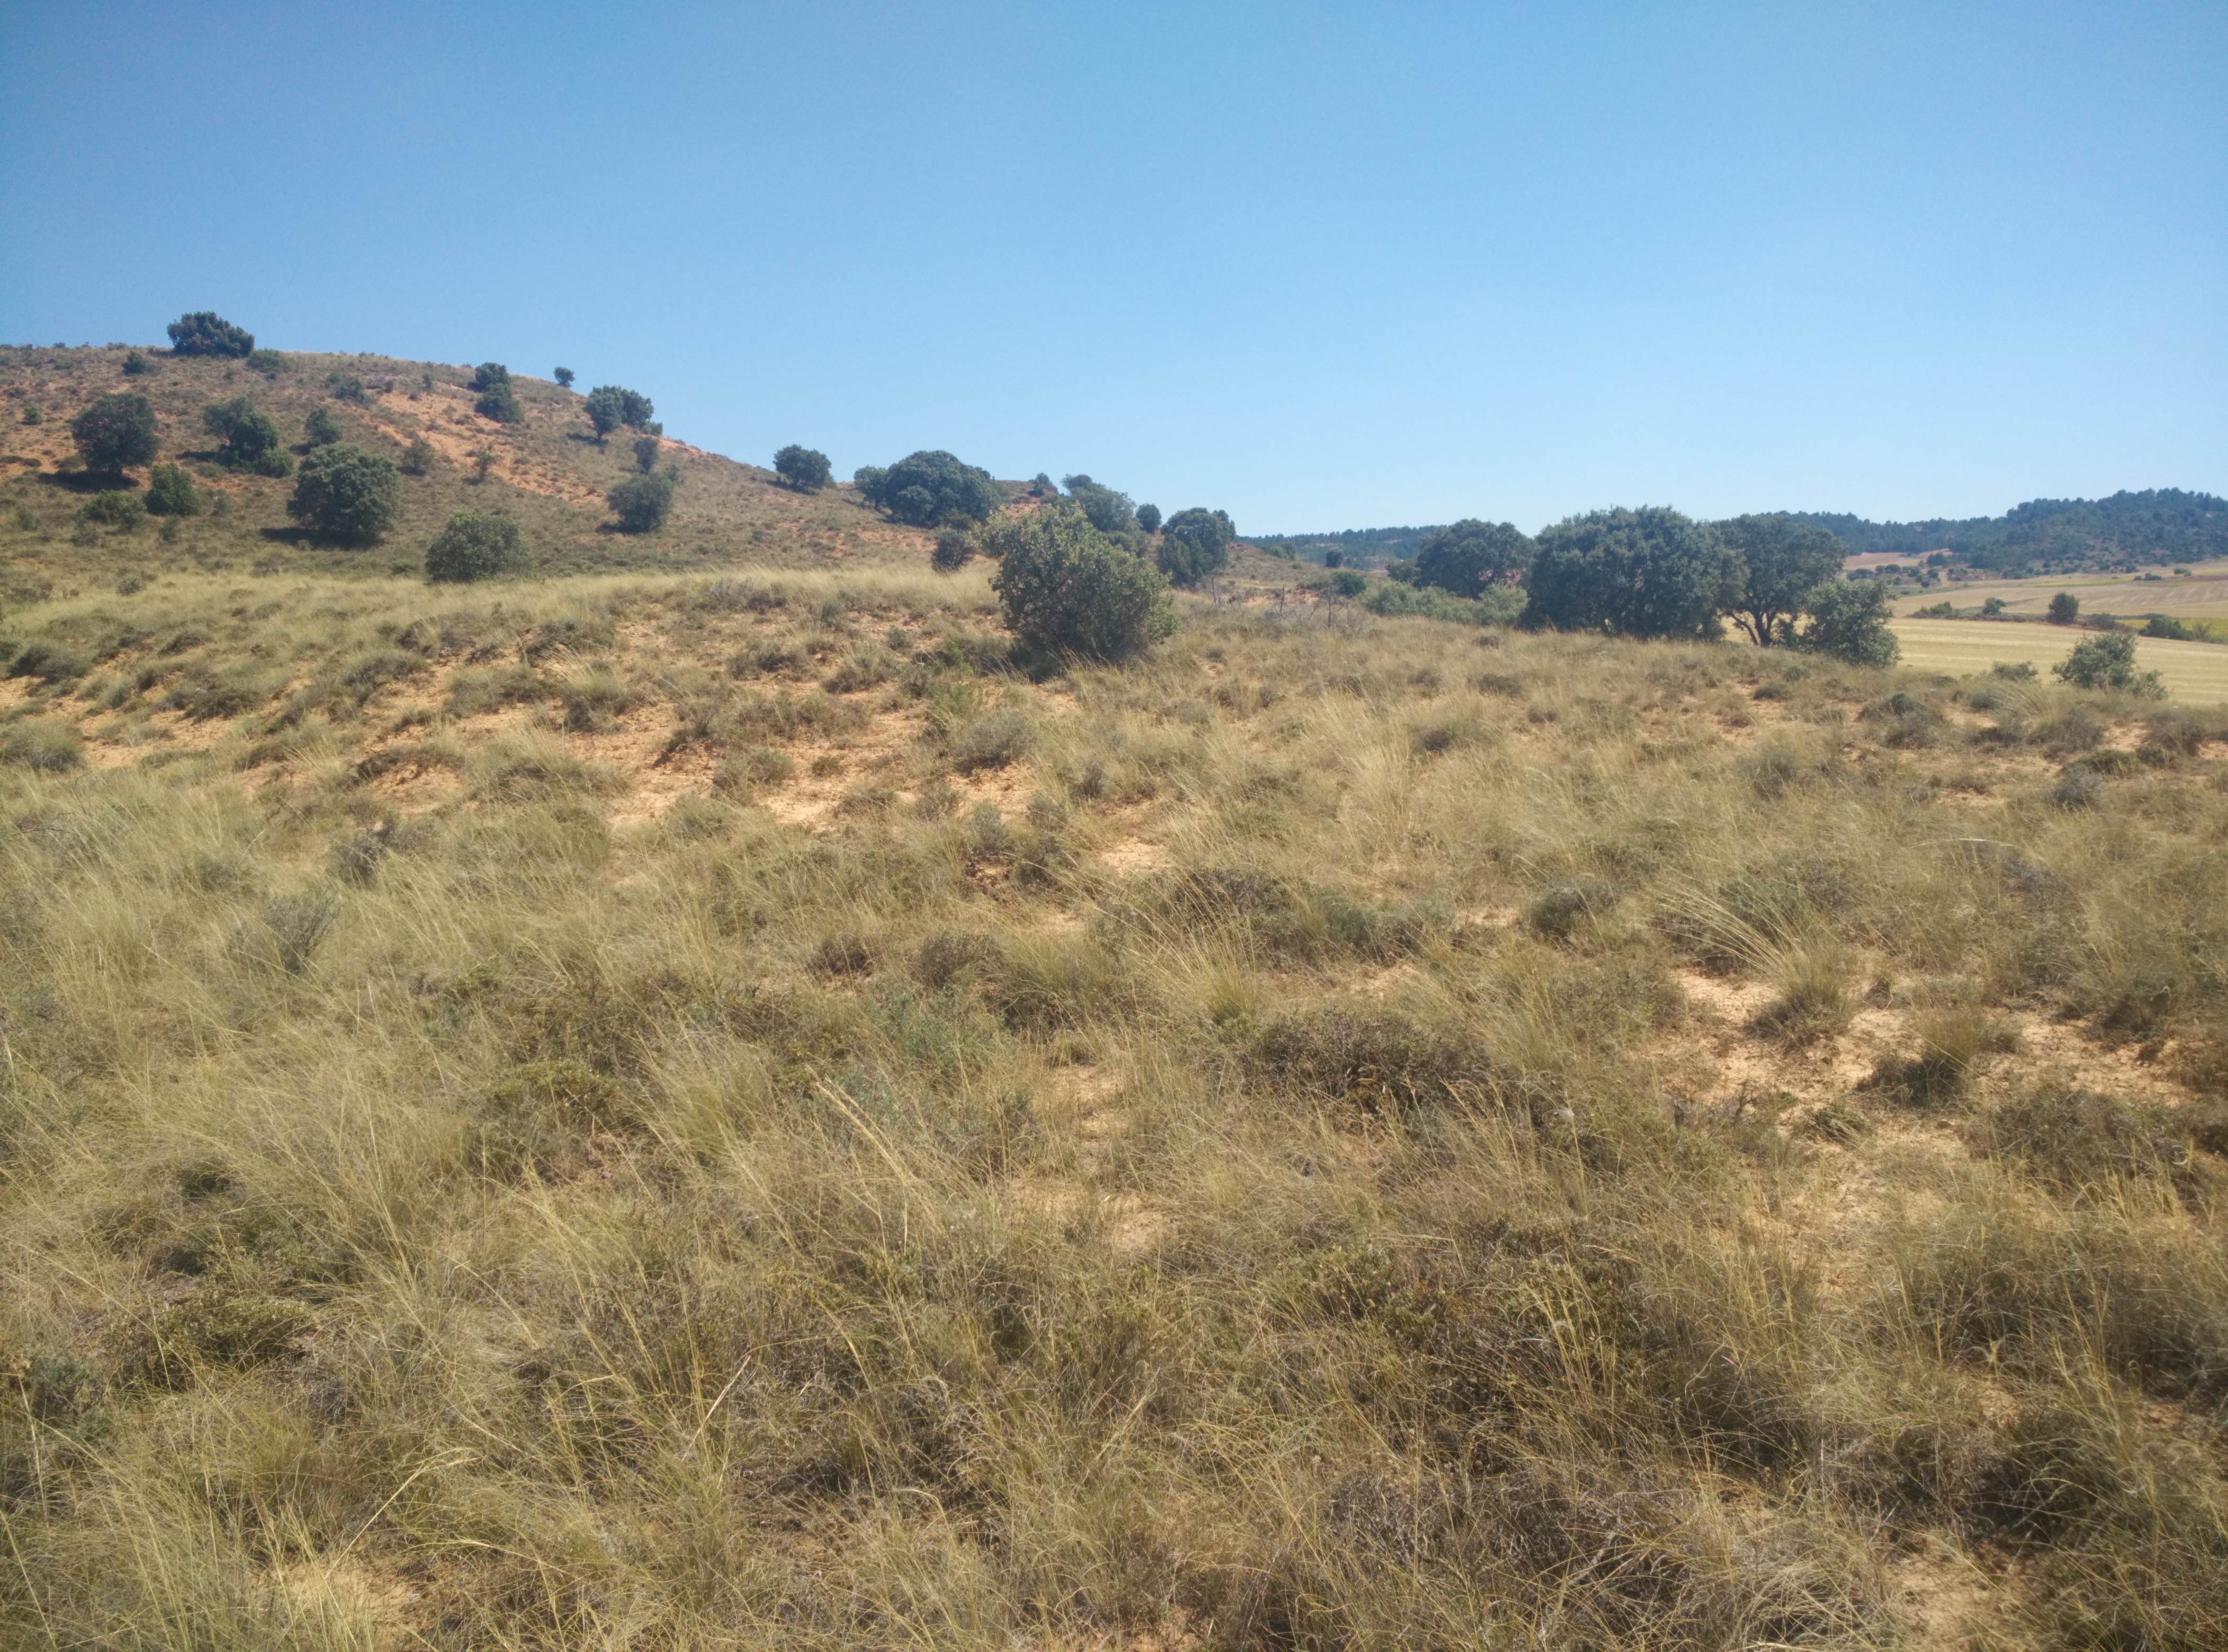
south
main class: Shrubland
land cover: Shrubland without tree cover
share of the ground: 25 - 50 %
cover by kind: shrubs 40 %, unconsolidated bare surface 40 %, herbaceous plants 20 %
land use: Semi-natural and natural areas not in use
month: July
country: ES
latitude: 40.8094
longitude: -2.7025
